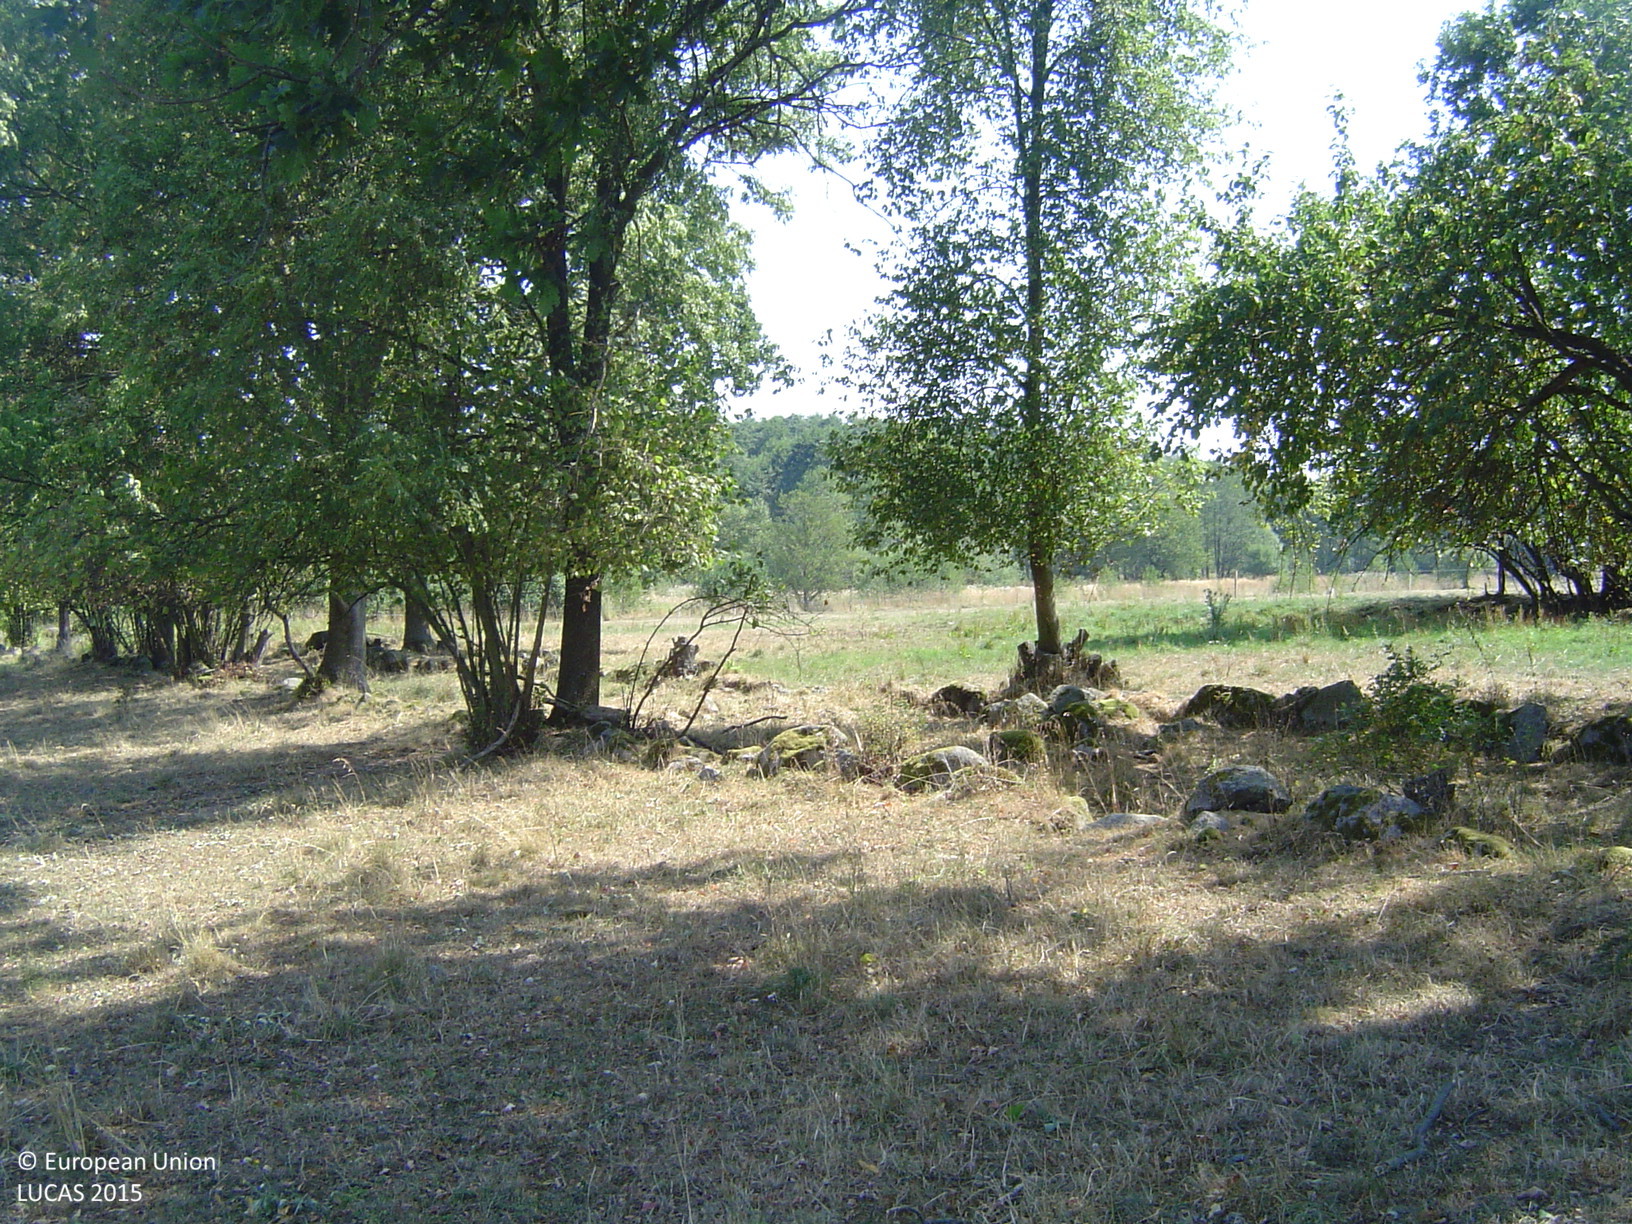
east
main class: Grassland
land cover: Grassland without tree/shrub cover
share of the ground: > 75 %
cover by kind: herbaceous plants 100 %
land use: Agriculture (excluding fallow land and kitchen gardens)
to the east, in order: Grassland without tree/shrub cover; Broadleaved woodland; Grassland without tree/shrub cover; Fences; Grassland without tree/shrub cover; Fences; Single bushes/trees; Ditches and canals; Spontaneously vegetated surfaces; Shrubland without tree cover; Spontaneously vegetated surfaces; Broadleaved woodland
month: August
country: CZ
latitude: 49.5956
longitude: 14.3870
